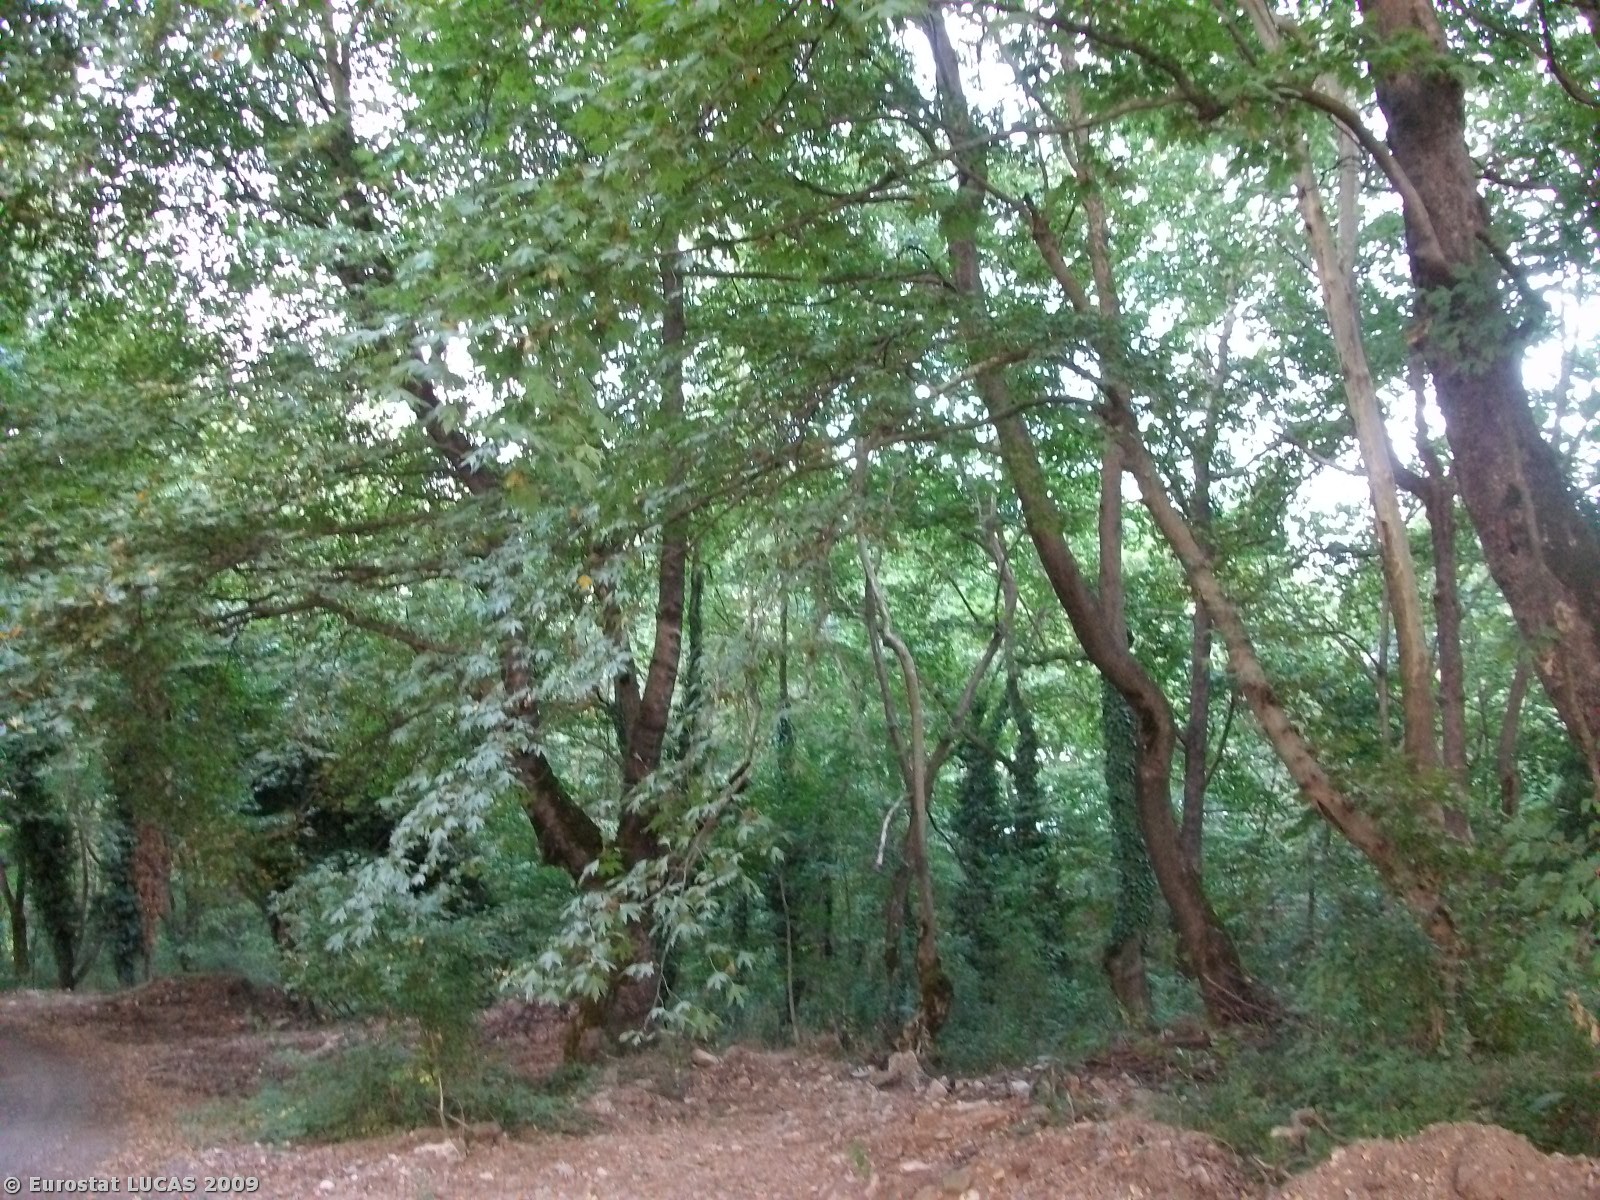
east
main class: Woodland
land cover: Broadleaved woodland
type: floodplain forest
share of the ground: > 75 %
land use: Unused
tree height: > 5 m
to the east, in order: Bare land; Broadleaved woodland; Rivers and streams; Broadleaved woodland; Grassland without tree/shrub cover; Lines of trees; Grassland without tree/shrub cover; Grassland with sparse tree/shrub cover
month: August
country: GR
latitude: 39.4116
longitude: 21.6064
